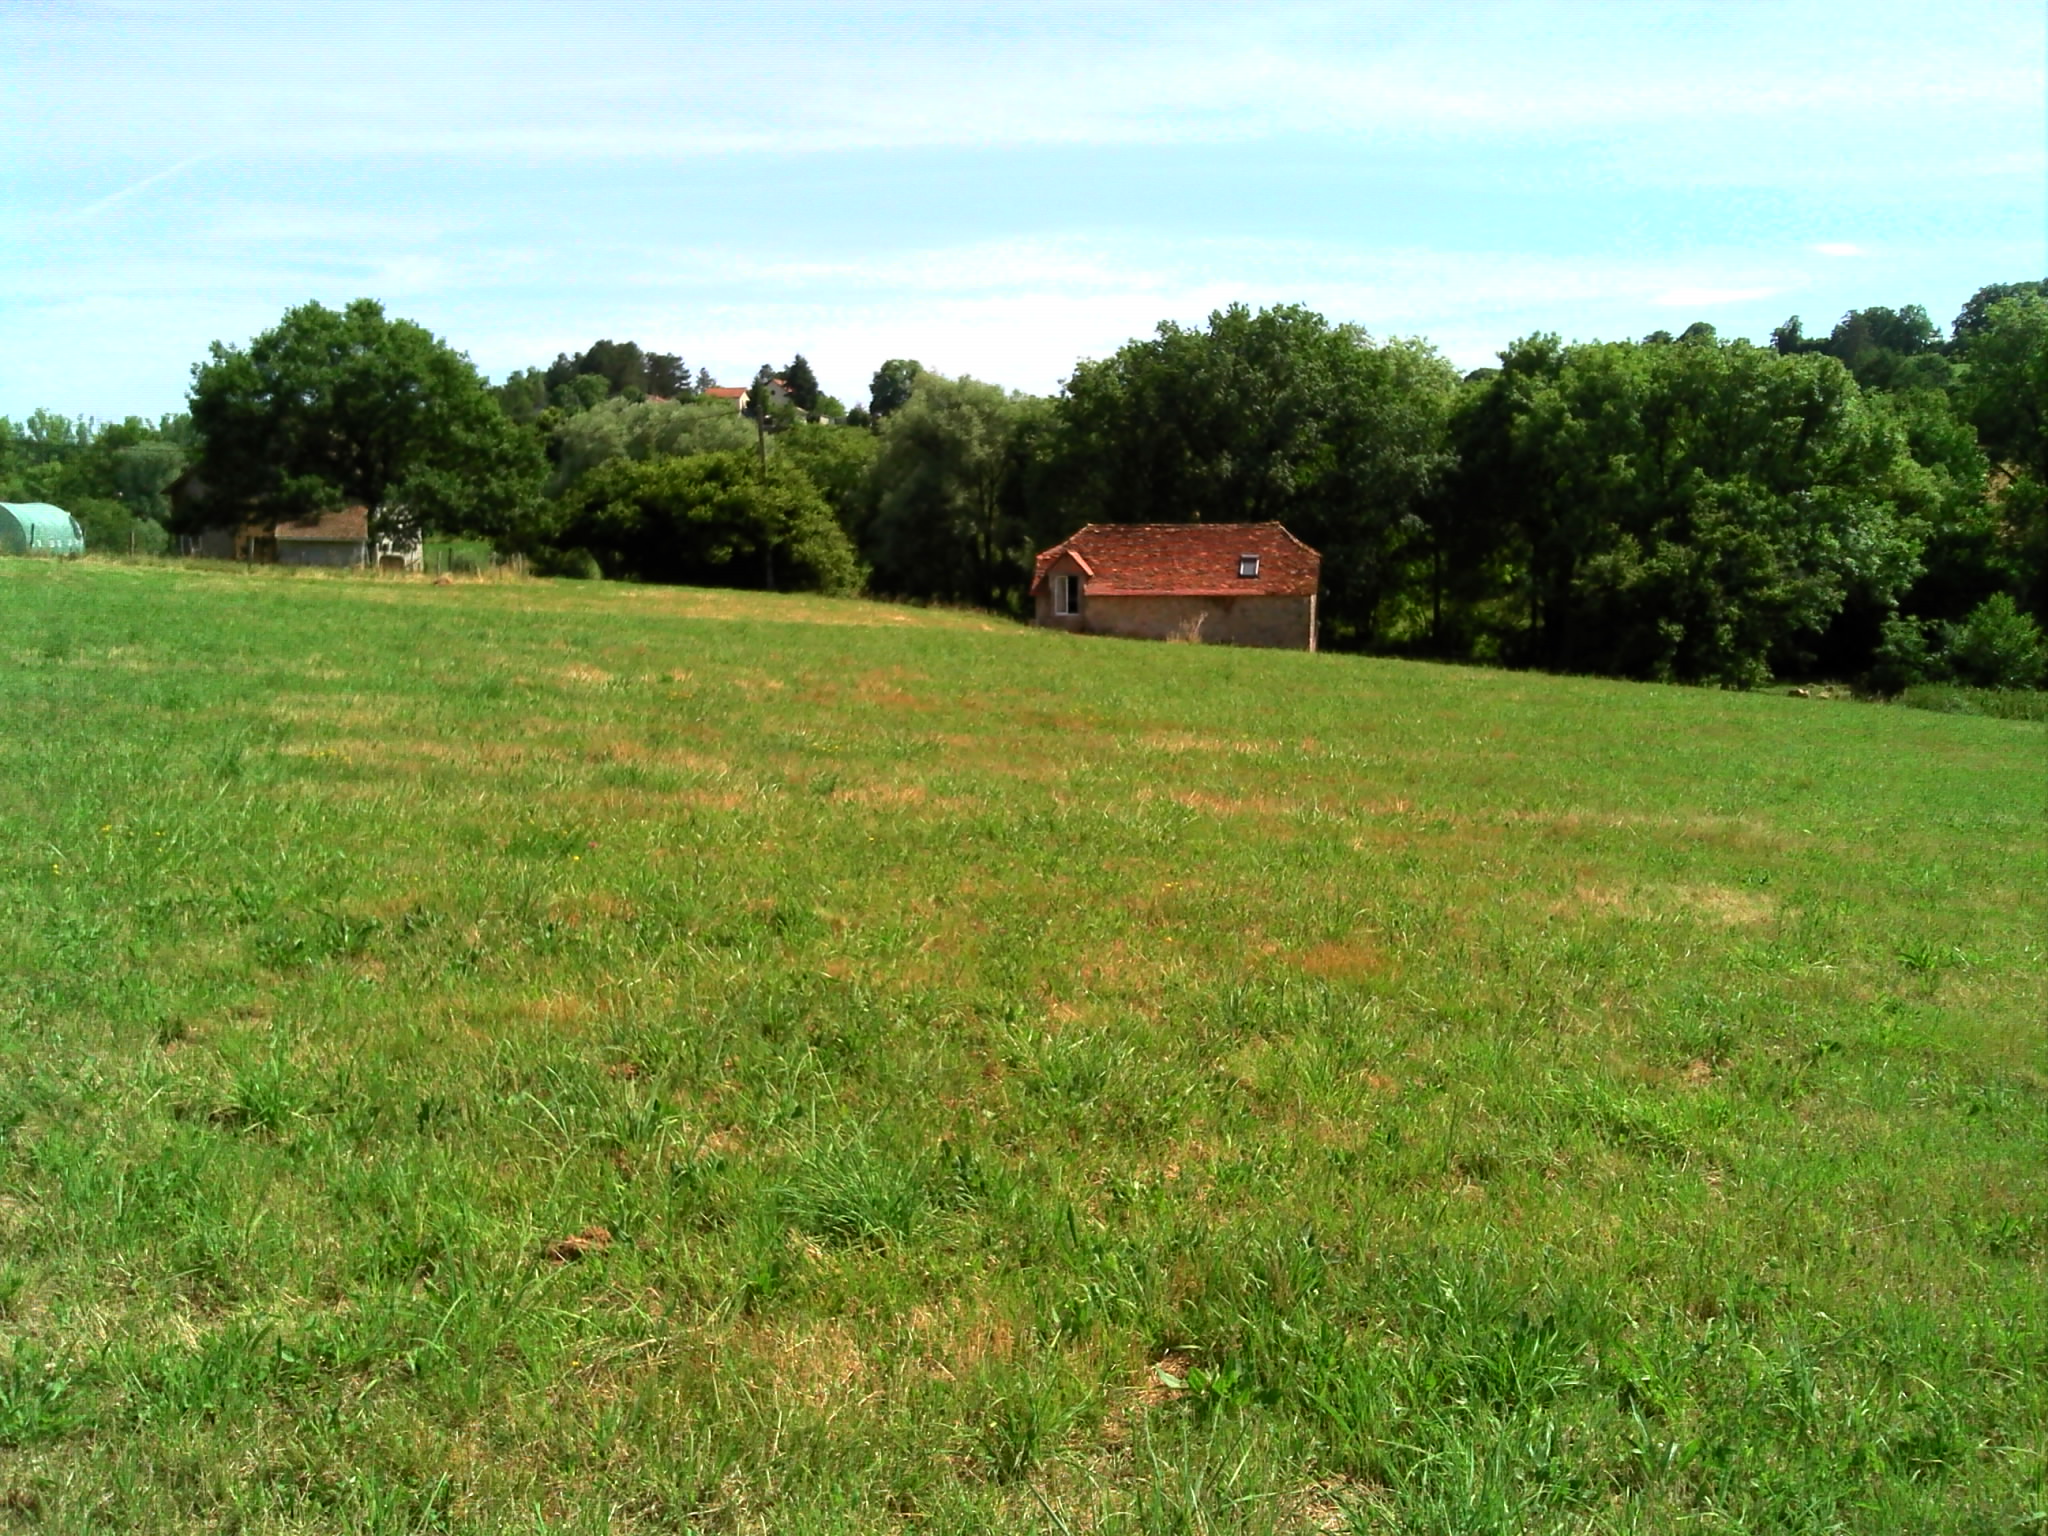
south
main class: Grassland
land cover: Grassland without tree/shrub cover
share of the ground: > 75 %
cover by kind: herbaceous plants 100 %
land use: Agriculture (excluding fallow land and kitchen gardens)
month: June
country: FR
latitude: 44.7902
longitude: 1.8459
